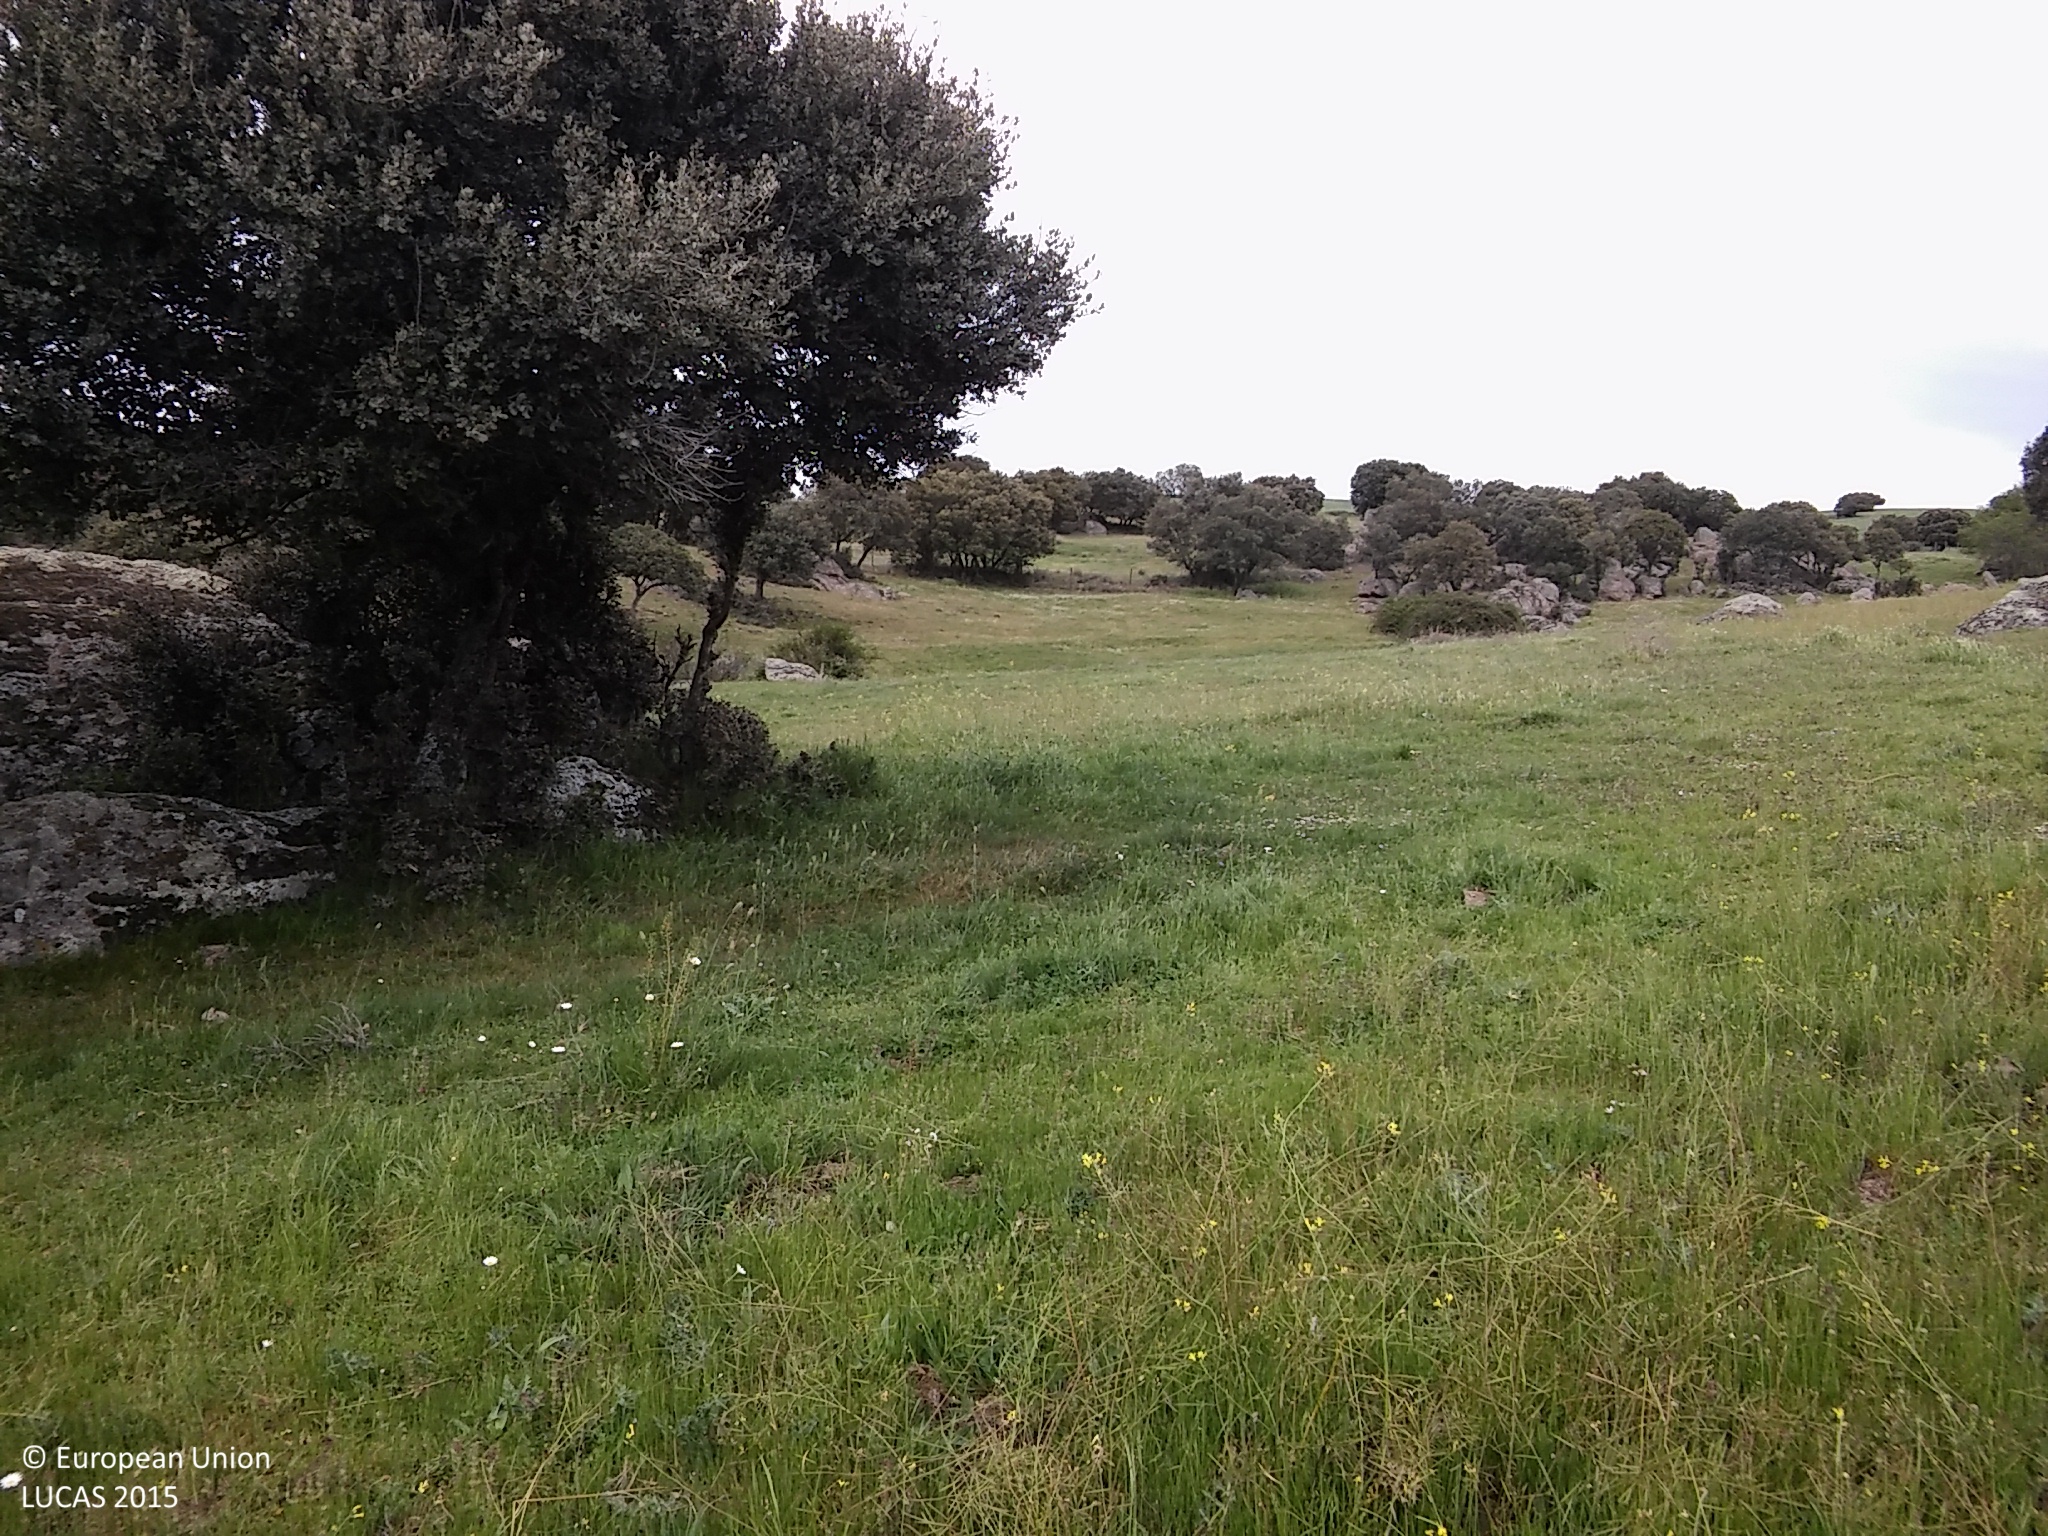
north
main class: Grassland
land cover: Grassland with sparse tree/shrub cover
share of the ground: > 75 %
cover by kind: herbaceous plants 90 %, broadleaved forest trees 5 %, shrubs 5 %
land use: Agriculture (excluding fallow land and kitchen gardens)
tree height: > 5 m
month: May
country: ES
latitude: 41.0673
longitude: -4.0337
